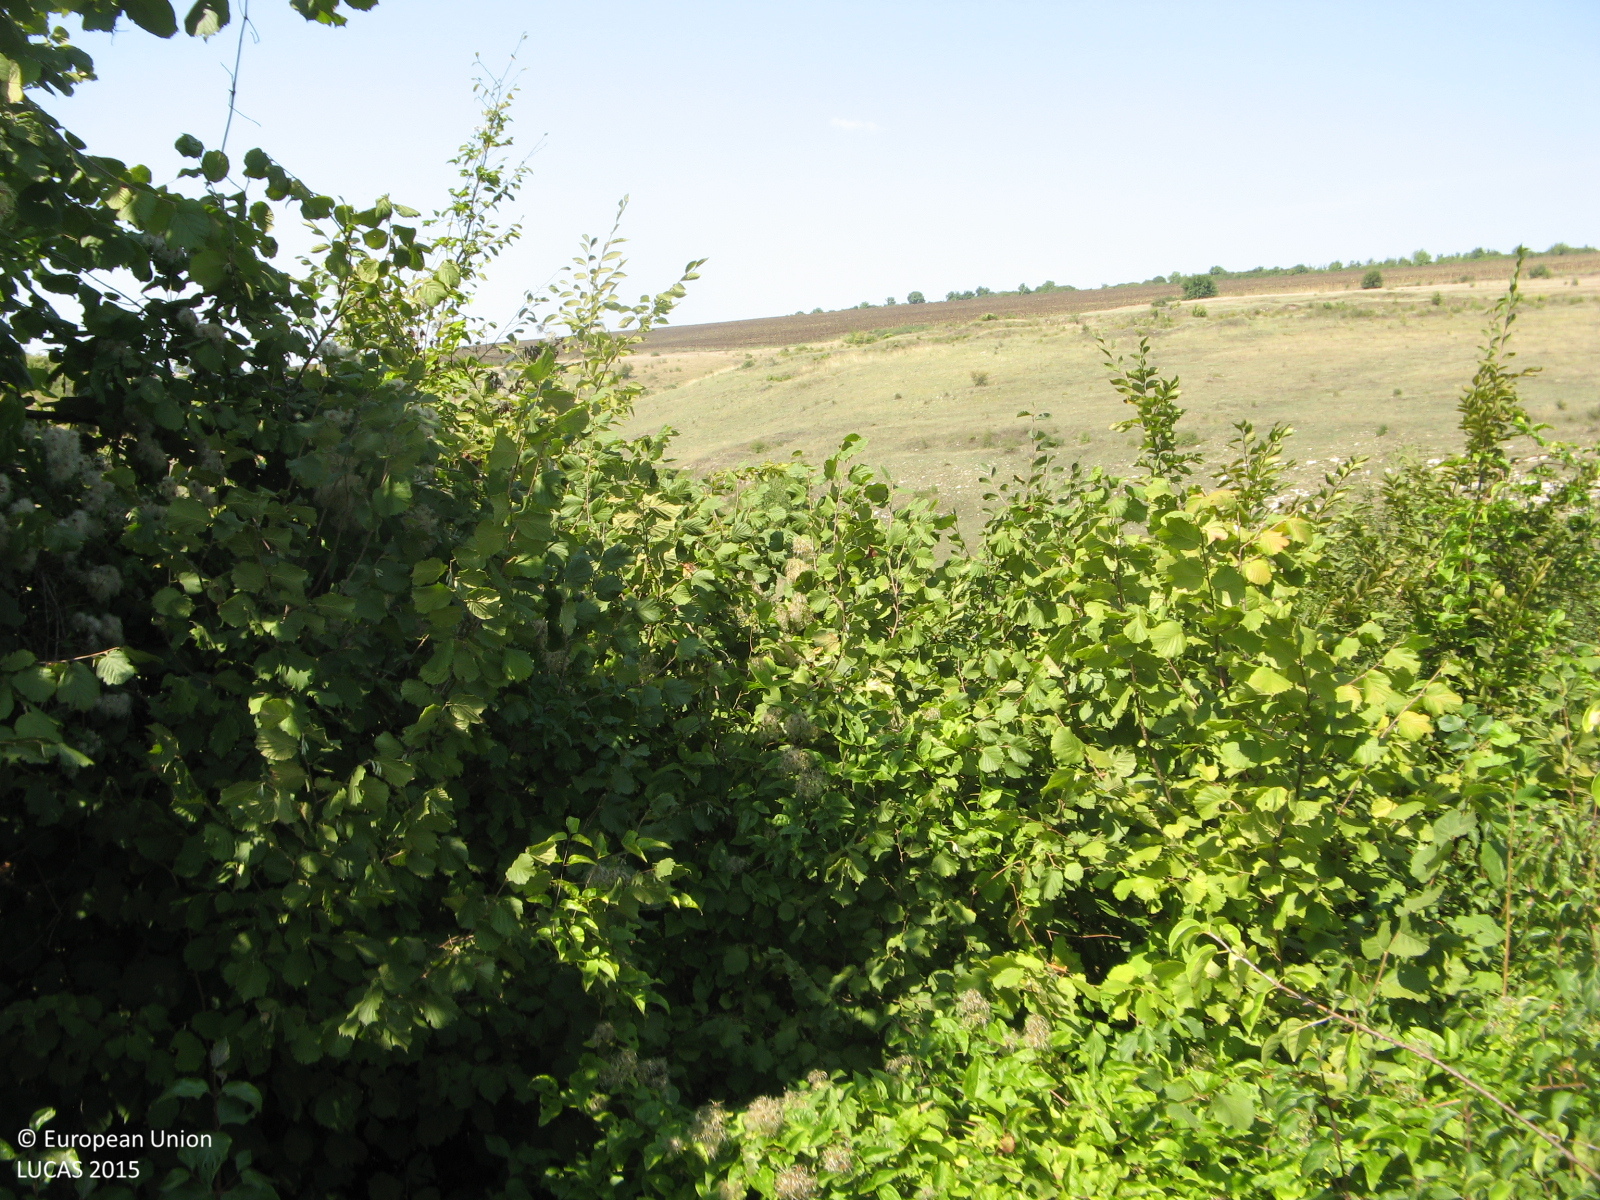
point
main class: Shrubland
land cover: Shrubland with sparse tree cover
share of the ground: > 75 %
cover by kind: shrubs 90 %, broadleaved forest trees 5 %, herbaceous plants 5 %
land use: Semi-natural and natural areas not in use
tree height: > 5 m
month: August
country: BG
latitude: 43.5069
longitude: 25.8599
